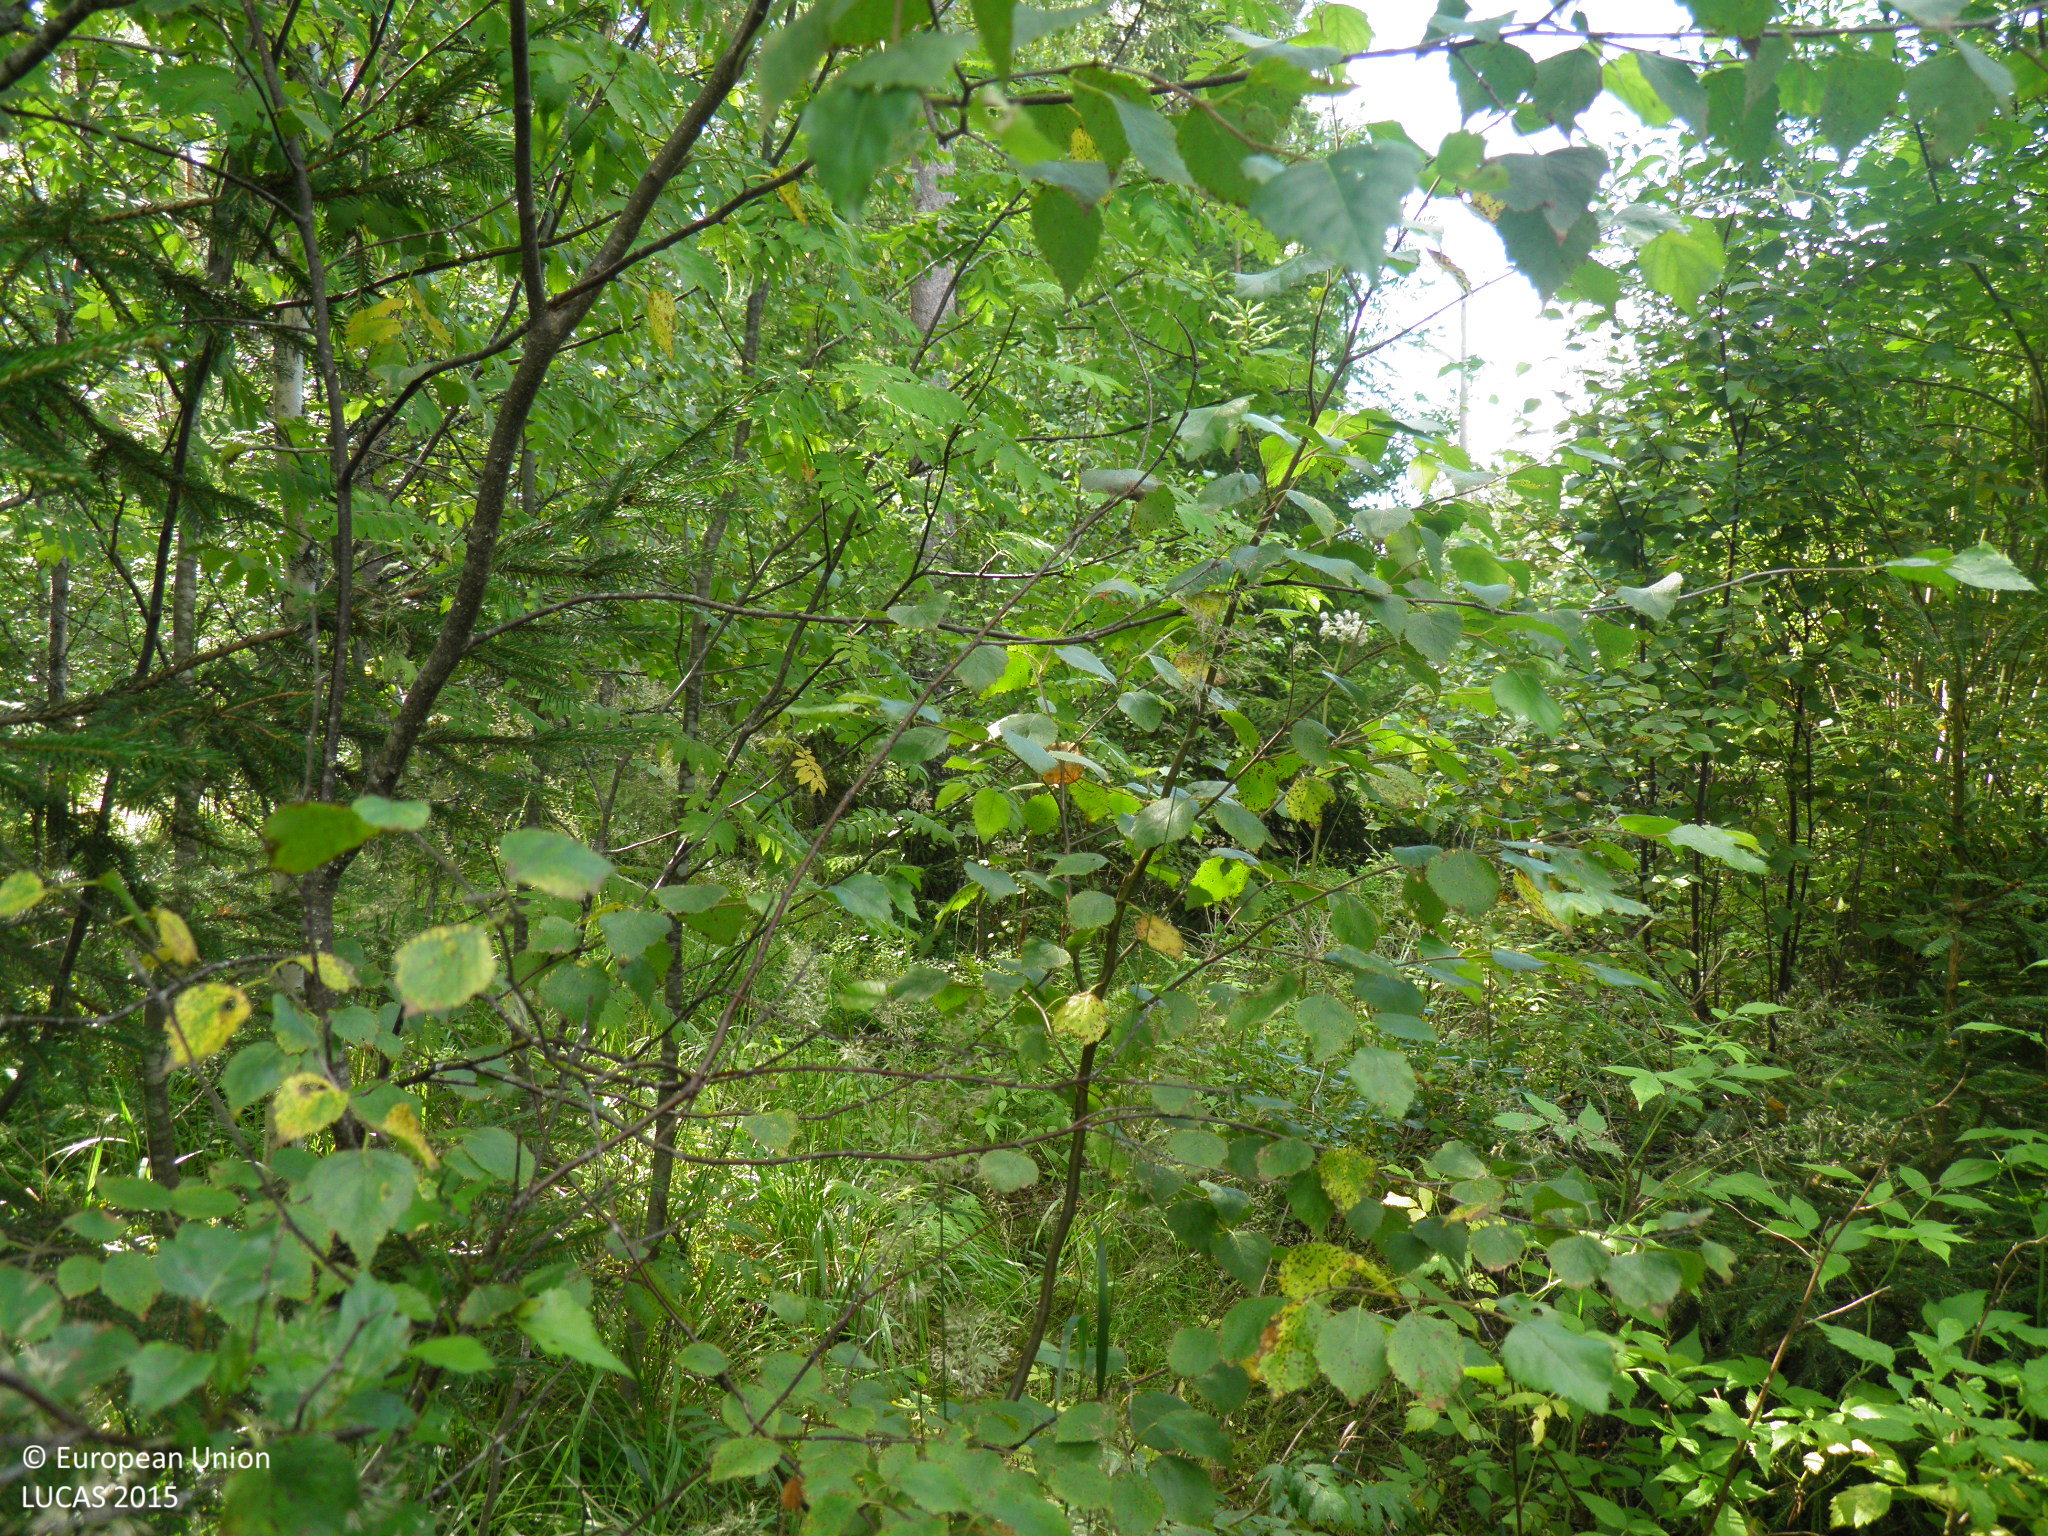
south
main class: Woodland
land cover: Pine dominated mixed woodland
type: hemiboreal forest and nemoral coniferous forest and mixed broadleaved-coniferous forest
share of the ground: 50 - 75 %
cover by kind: coniferous forest trees 40 %, broadleaved forest trees 30 %, shrubs 15 %, herbaceous plants 15 %
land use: Forestry
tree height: > 5 m
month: August
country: FI
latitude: 60.9736
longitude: 22.5011
